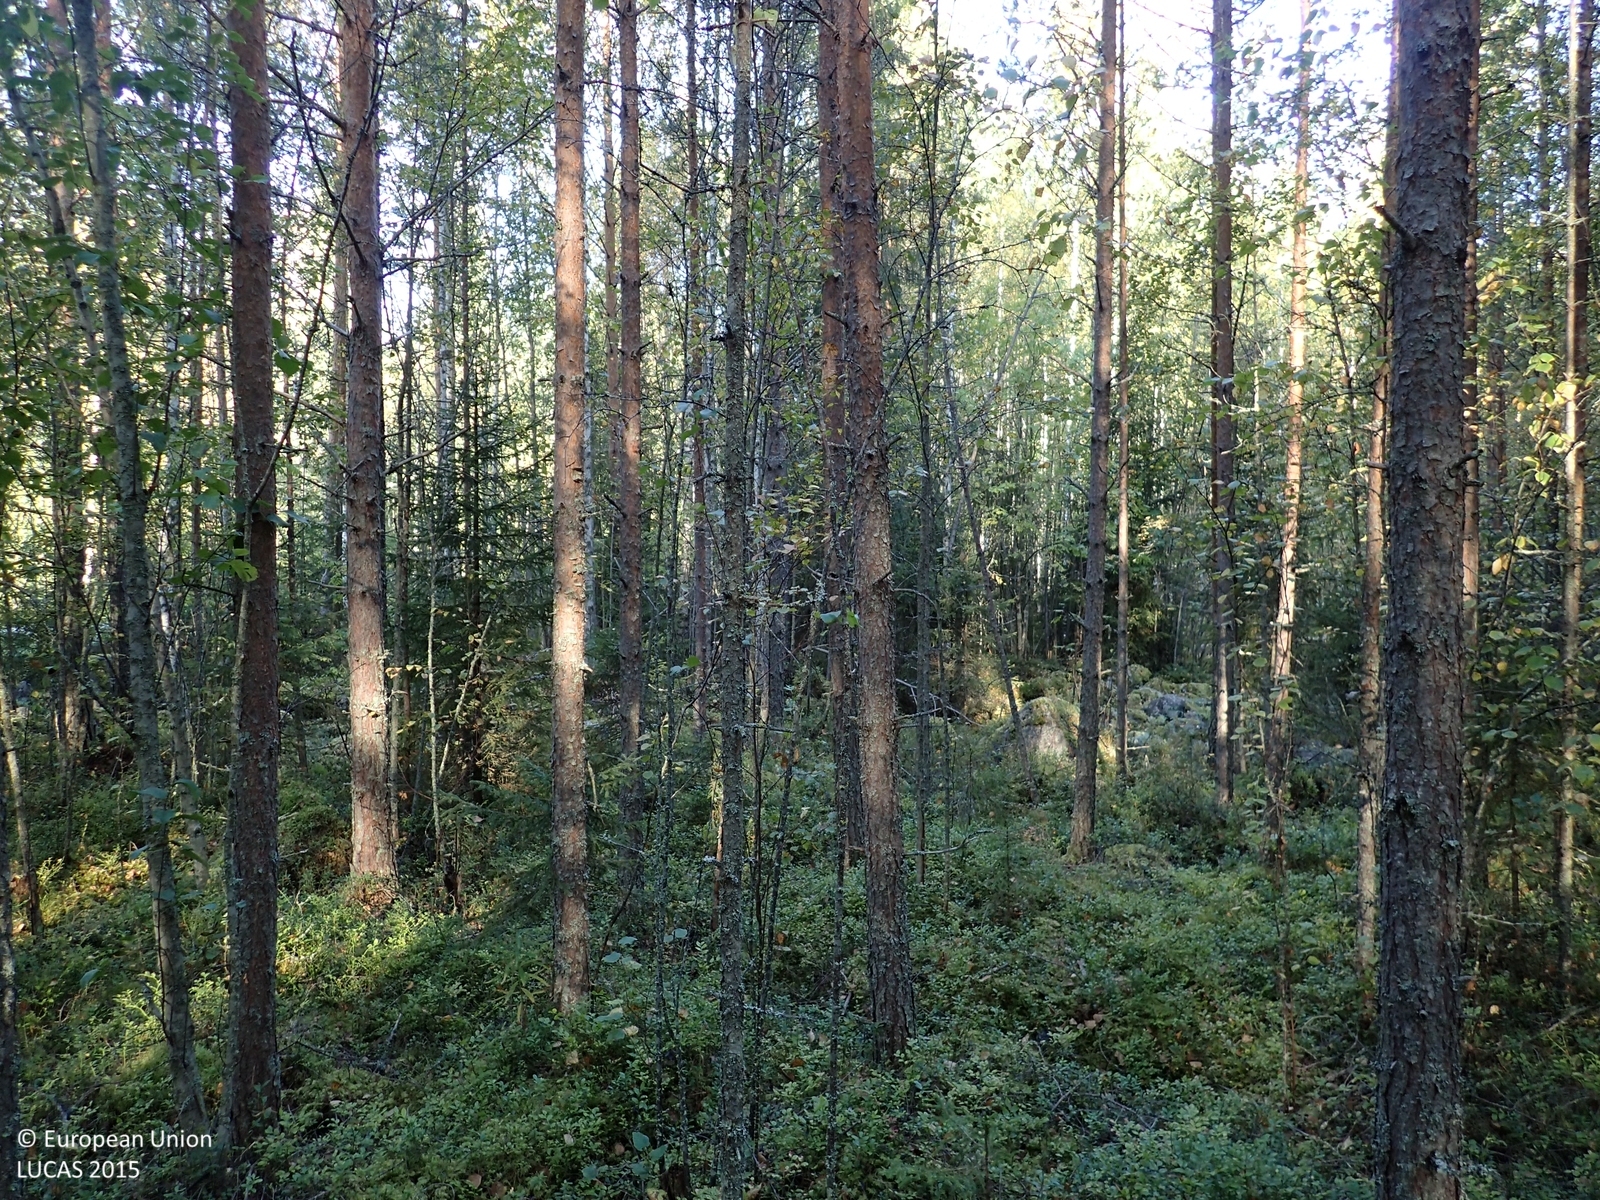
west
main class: Woodland
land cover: Pine dominated mixed woodland
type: boreal forest
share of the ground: > 75 %
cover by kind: coniferous forest trees 60 %, broadleaved forest trees 20 %, shrubs 15 %, lichens and mosses 5 %
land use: Forestry
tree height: > 5 m
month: September
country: FI
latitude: 62.9524
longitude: 25.2599
